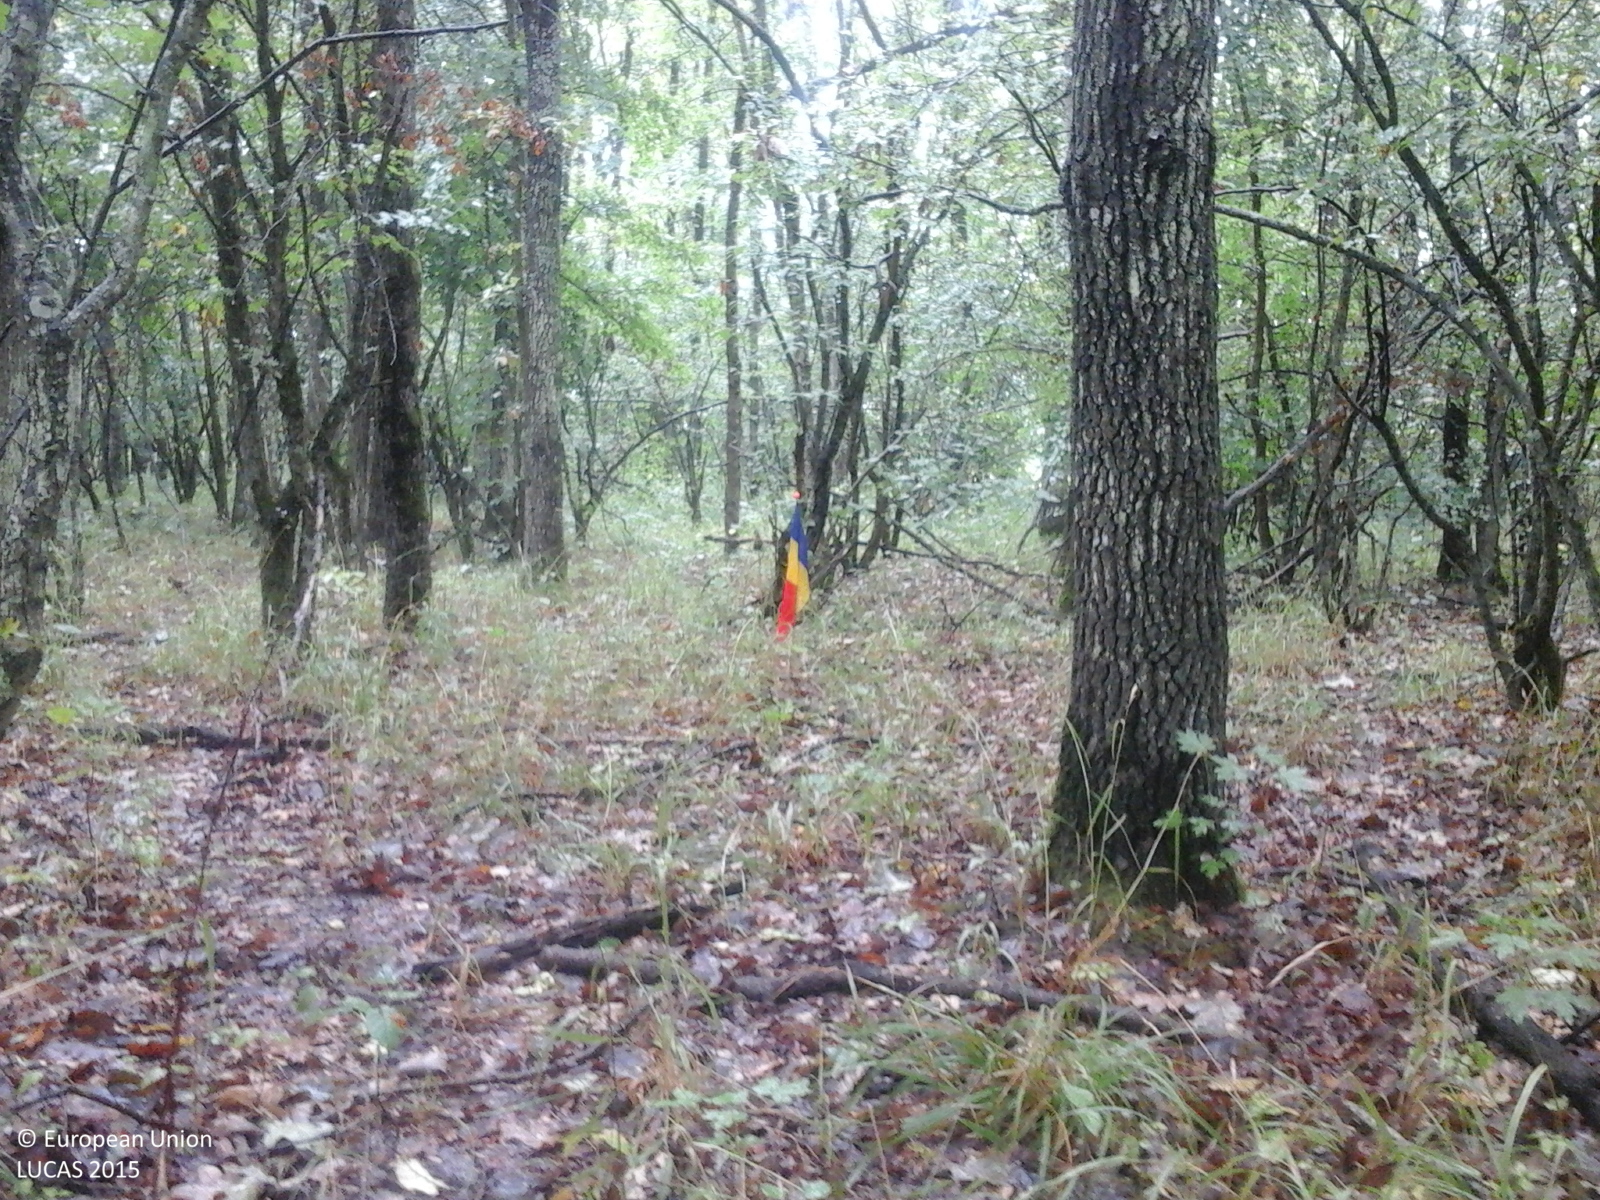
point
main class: Woodland
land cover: Broadleaved woodland
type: acidophilous oak and oak-birch forest
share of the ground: > 75 %
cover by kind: broadleaved forest trees 100 %
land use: Forestry
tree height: > 5 m
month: August
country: RO
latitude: 45.7128
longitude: 21.4792
